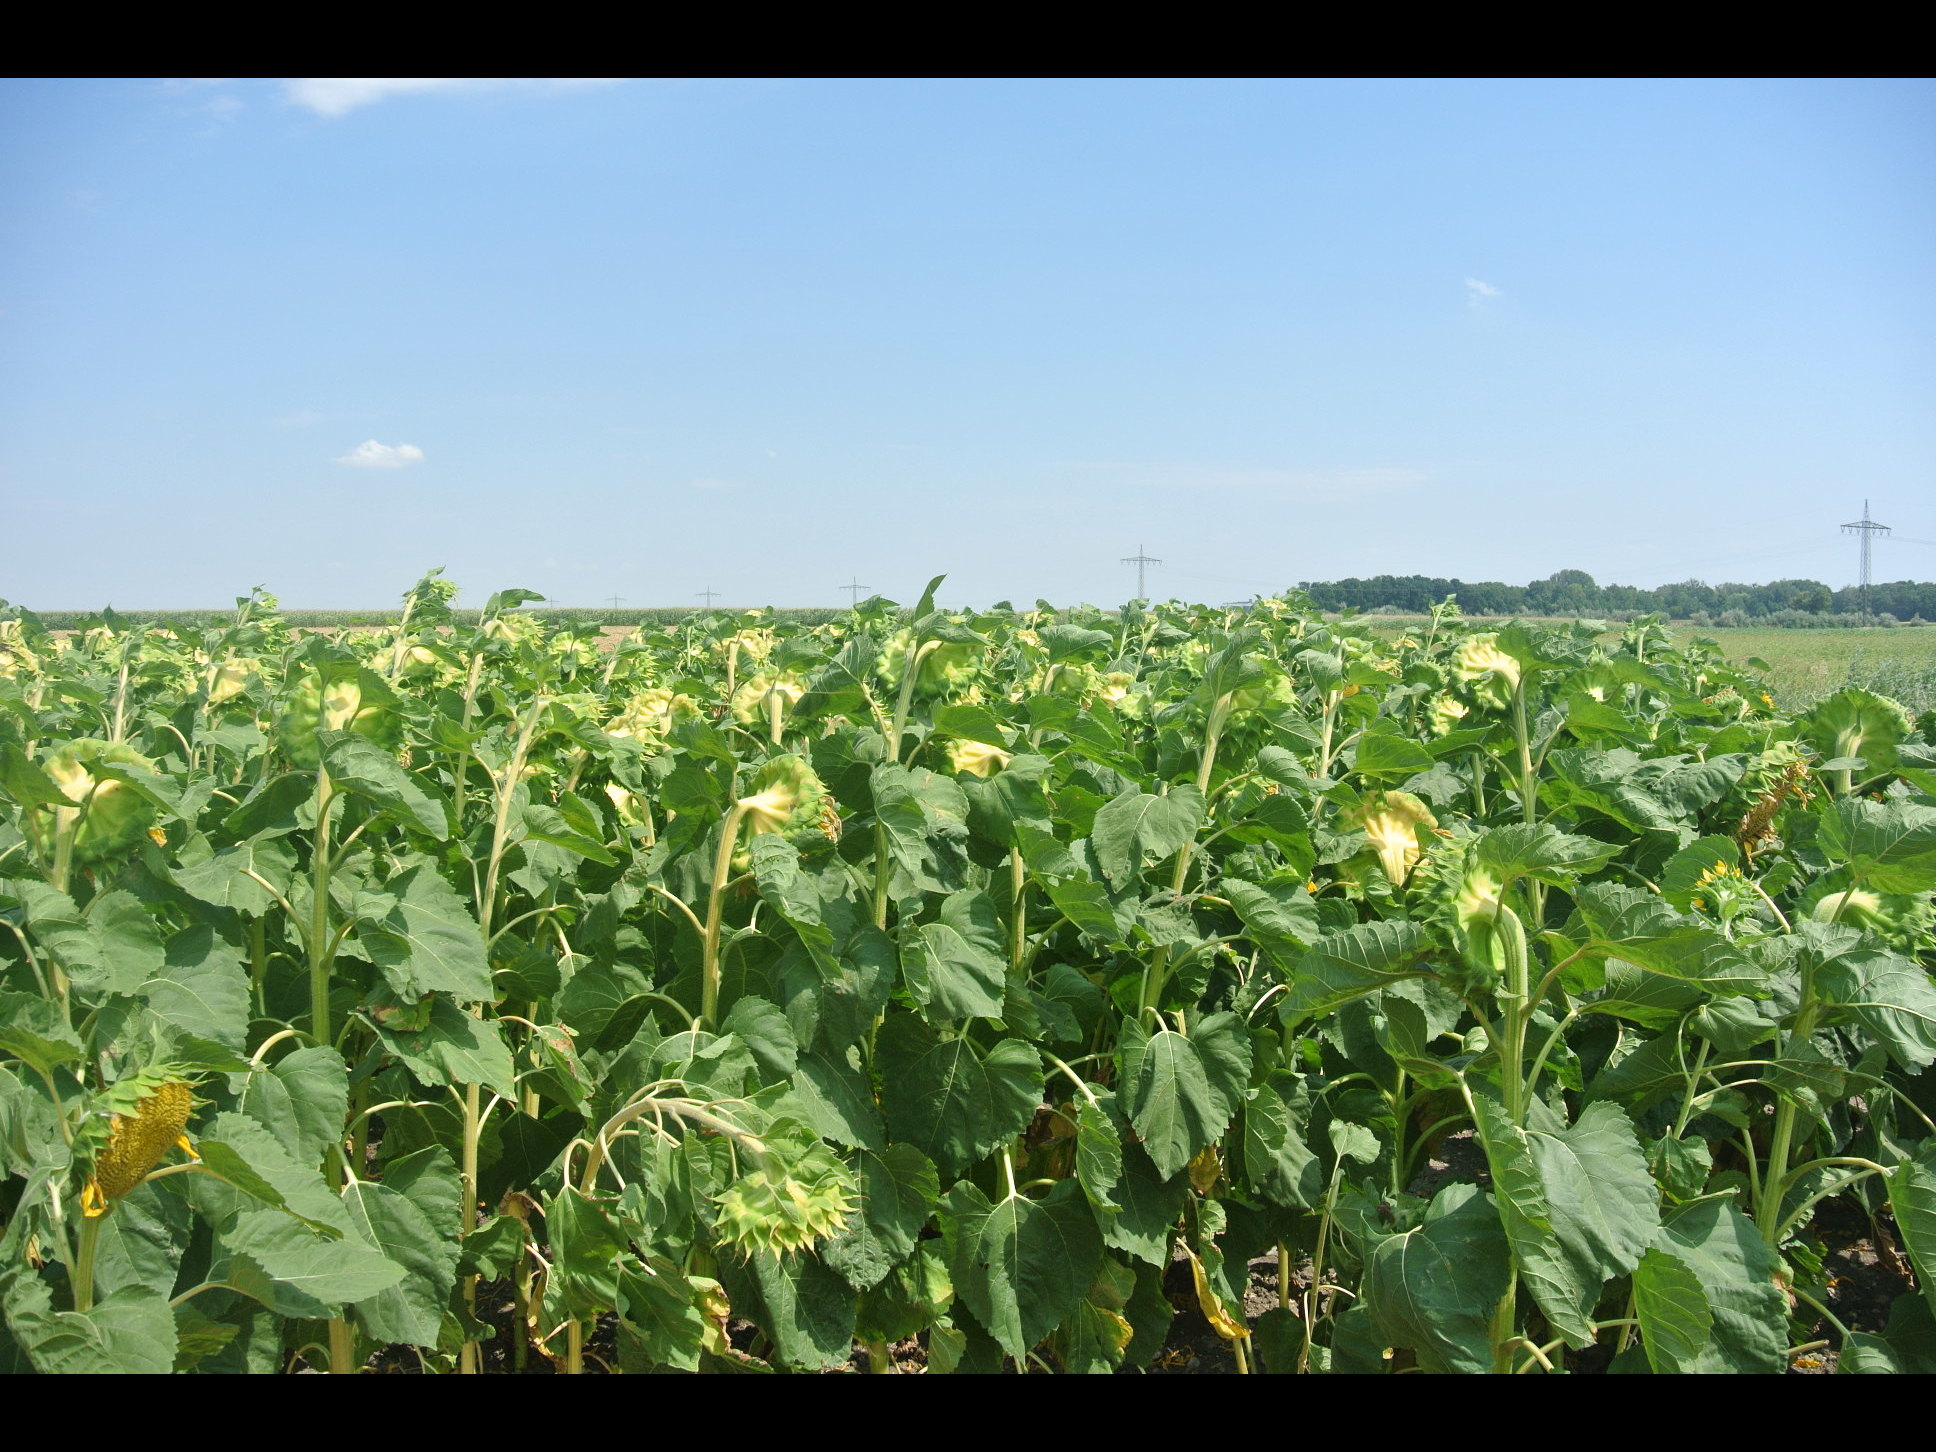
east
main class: Cropland
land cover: Common wheat
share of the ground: > 75 %
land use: Agriculture (excluding fallow land and kitchen gardens)
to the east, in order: Common wheat; Tracks; Spontaneously vegetated surfaces; Common wheat; Maize; Temporary grasslands
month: July
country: AT
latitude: 47.7364
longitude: 16.9002
